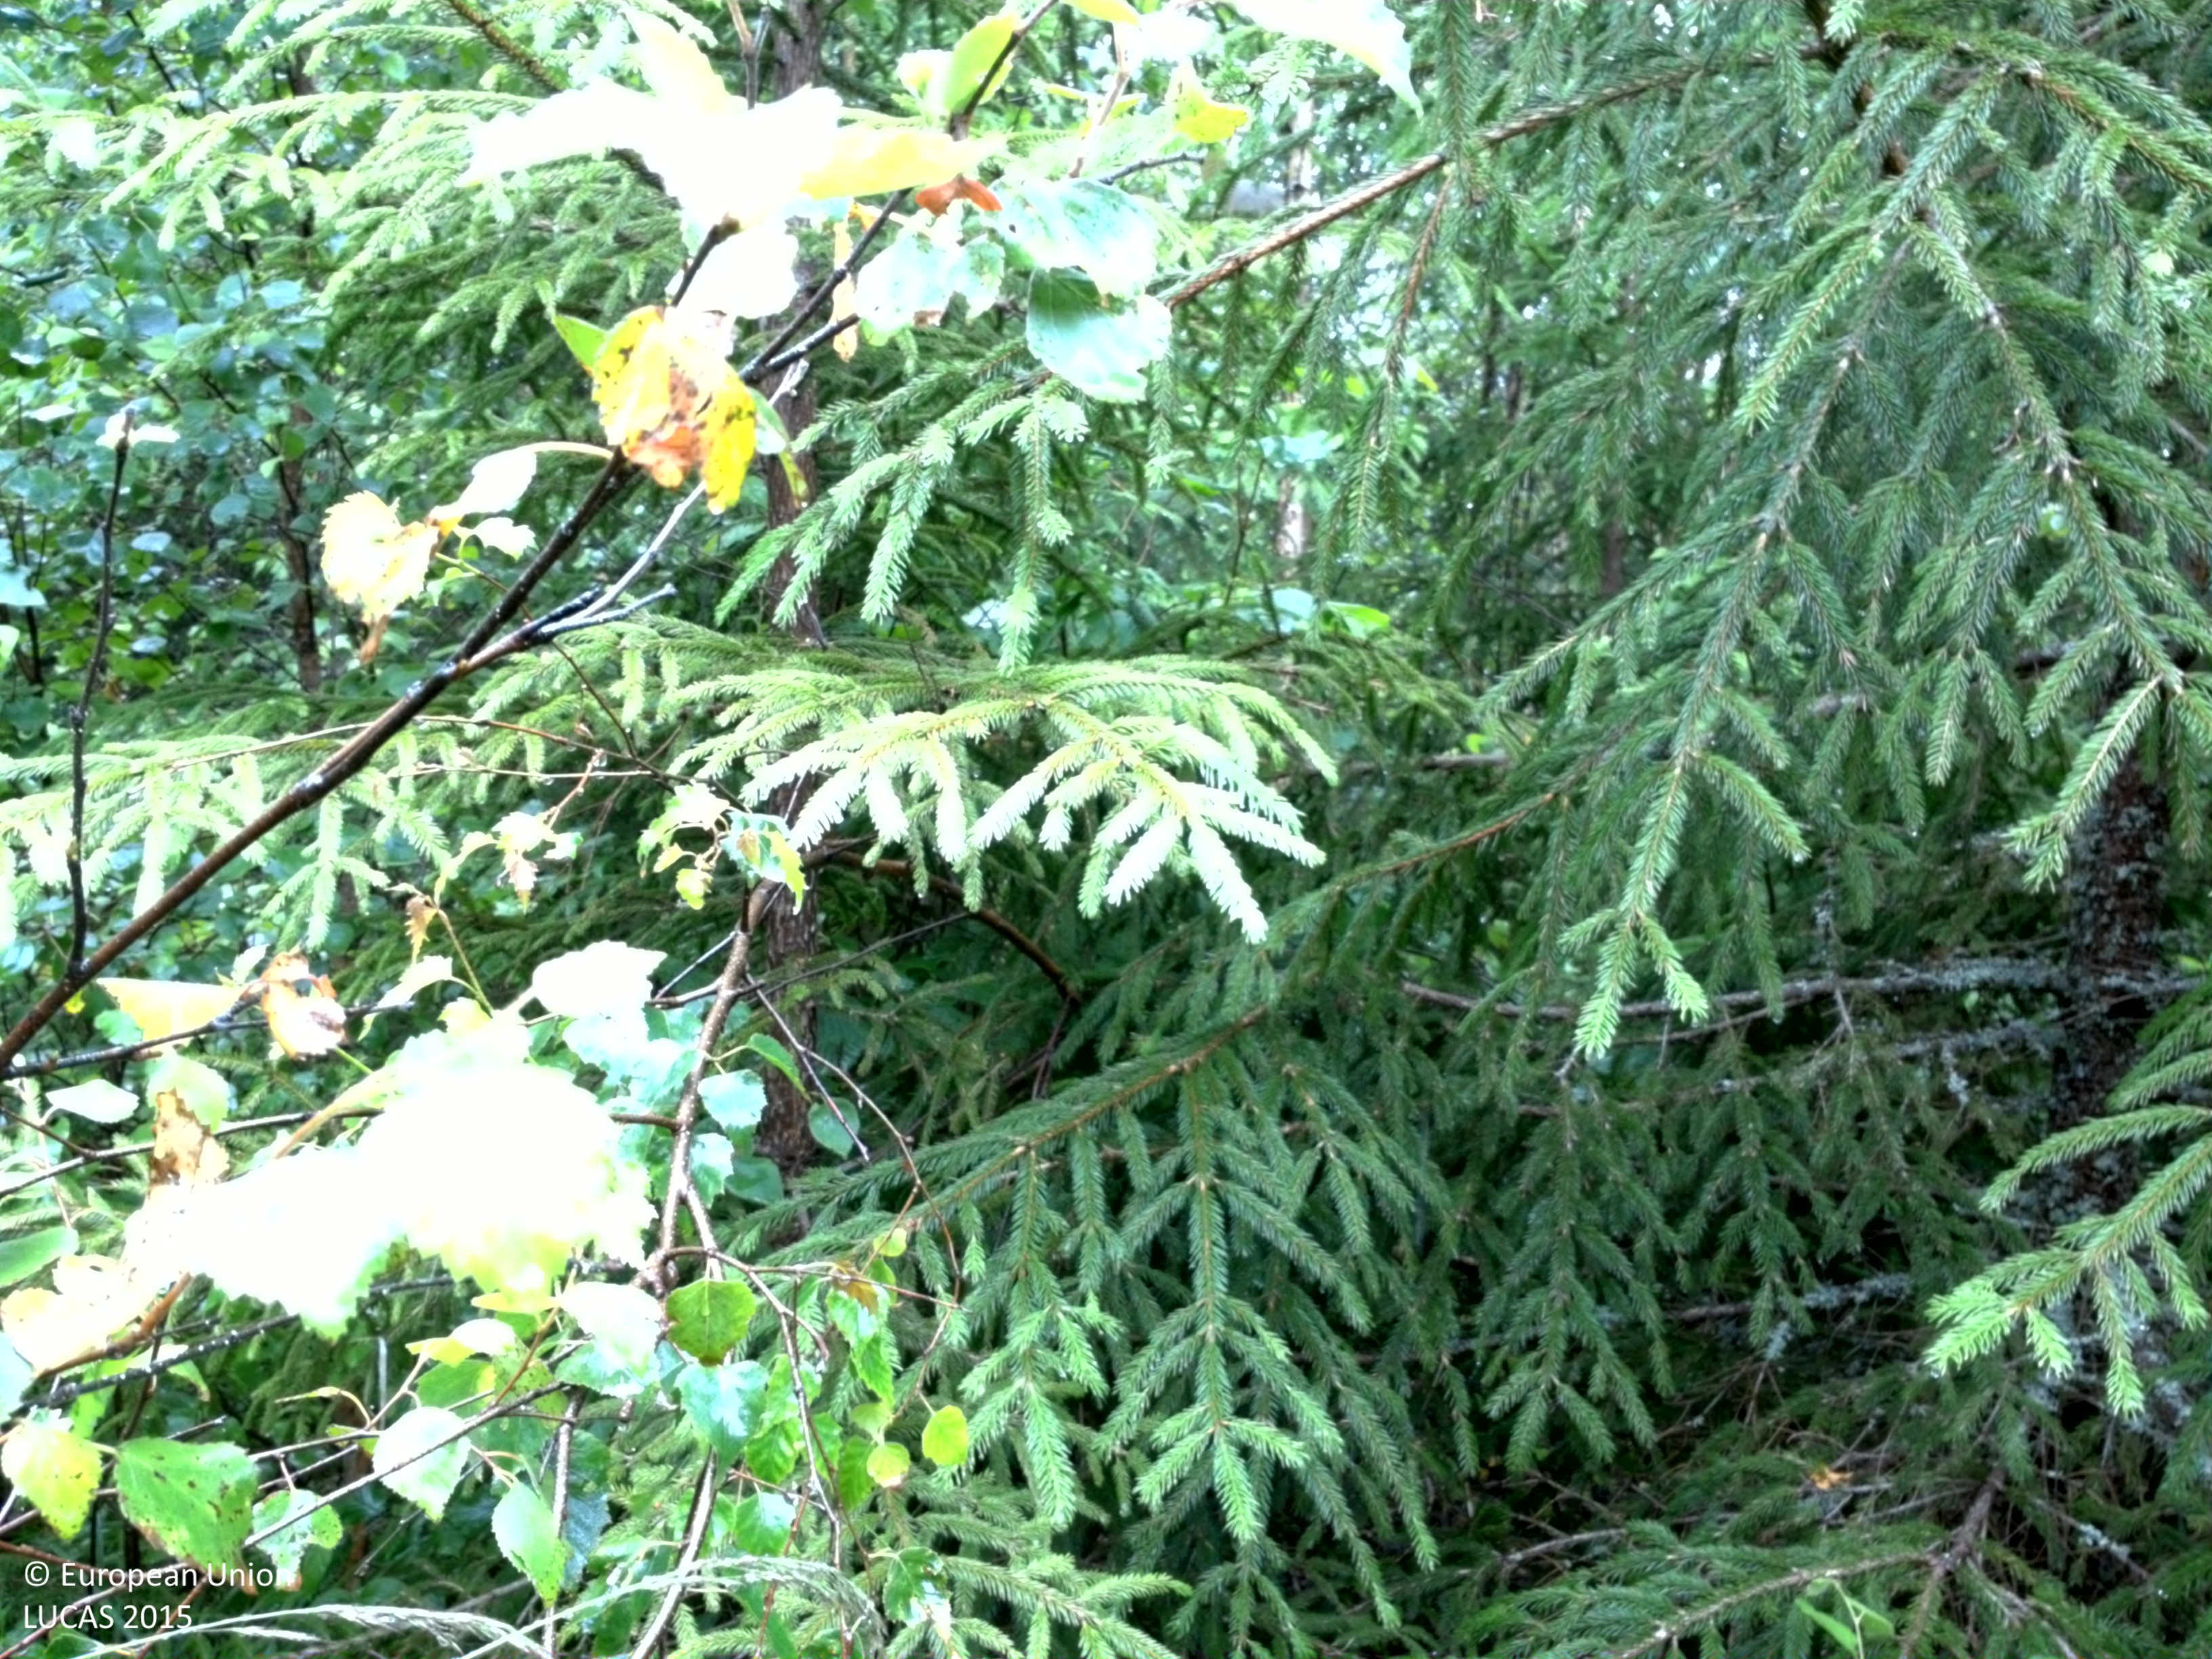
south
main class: Woodland
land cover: Spruce dominated mixed woodland
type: boreal forest
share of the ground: > 75 %
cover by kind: coniferous forest trees 50 %, broadleaved forest trees 40 %, herbaceous plants 5 %, lichens and mosses 5 %
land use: Forestry
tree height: > 5 m
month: July
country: SE
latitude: 59.8592
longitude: 18.3713
